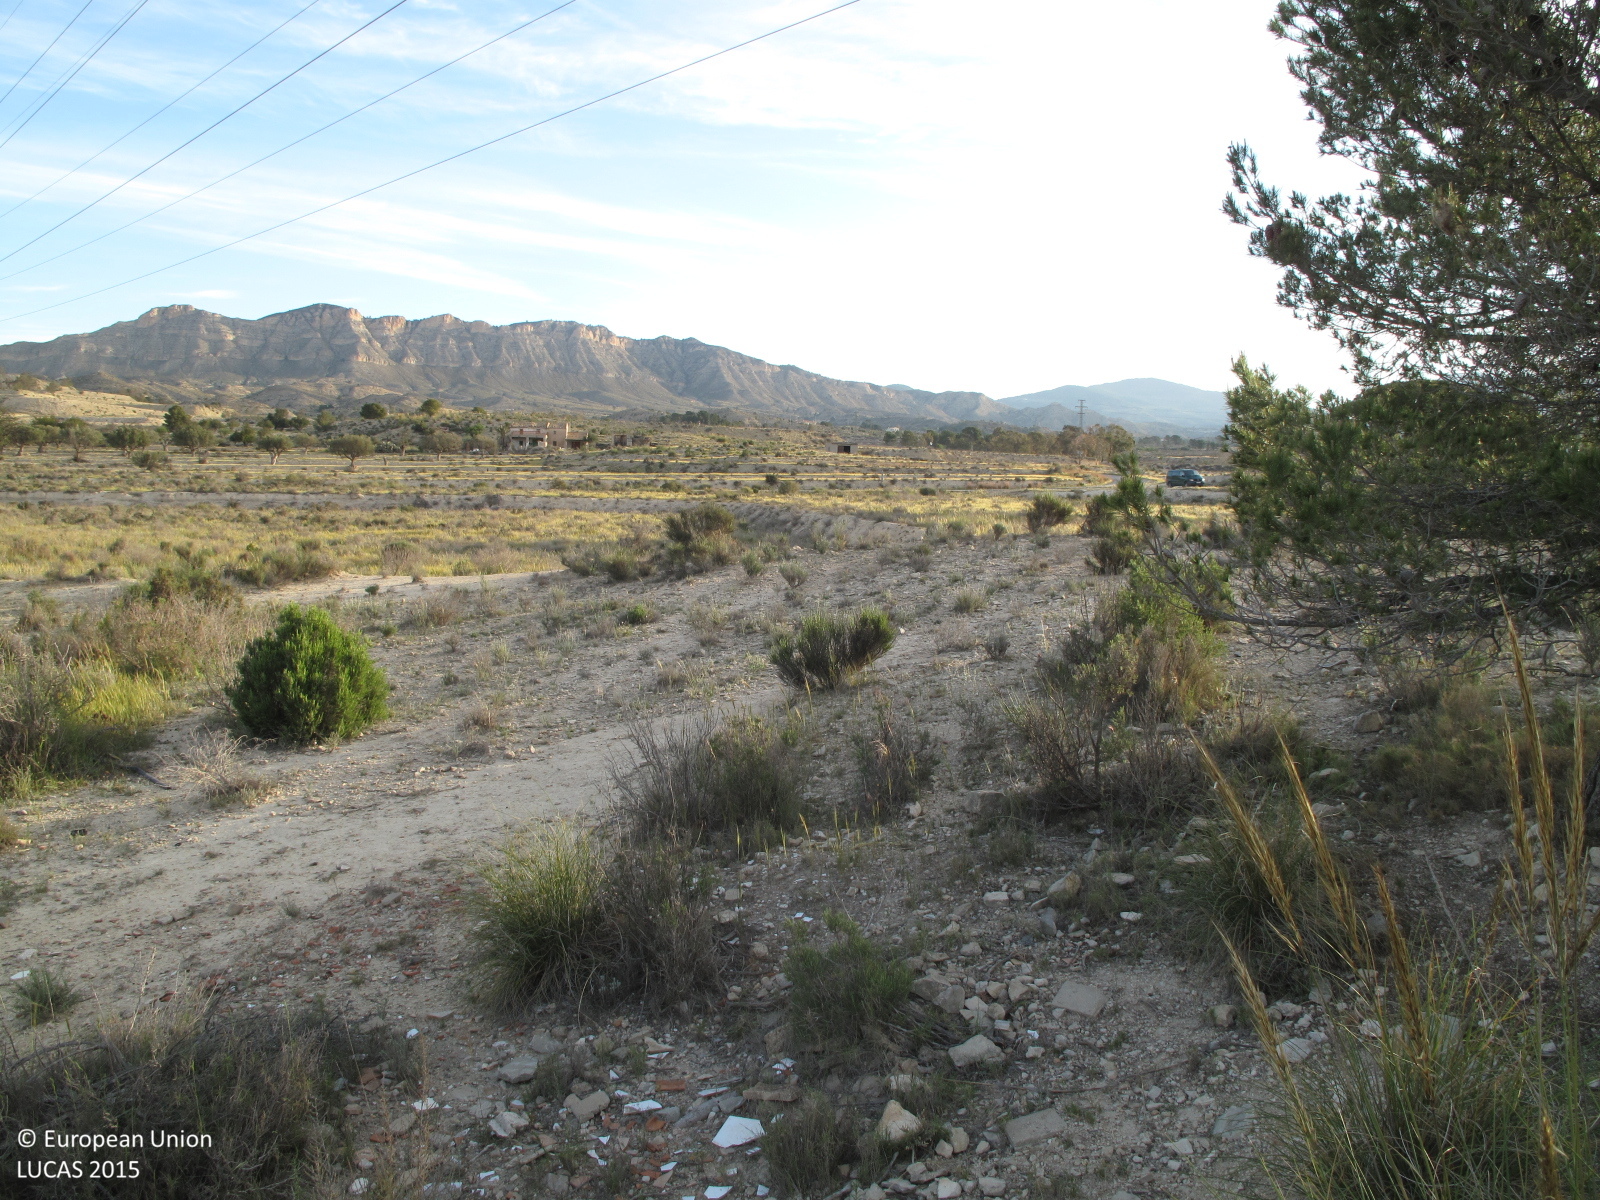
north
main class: Shrubland
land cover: Shrubland with sparse tree cover
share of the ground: 10 - 25 %
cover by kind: consolidated bare surface 75 %, shrubs 10 %, herbaceous plants 10 %, coniferous forest trees 5 %
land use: Semi-natural and natural areas not in use
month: April
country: ES
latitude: 38.5005
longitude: -0.4790
